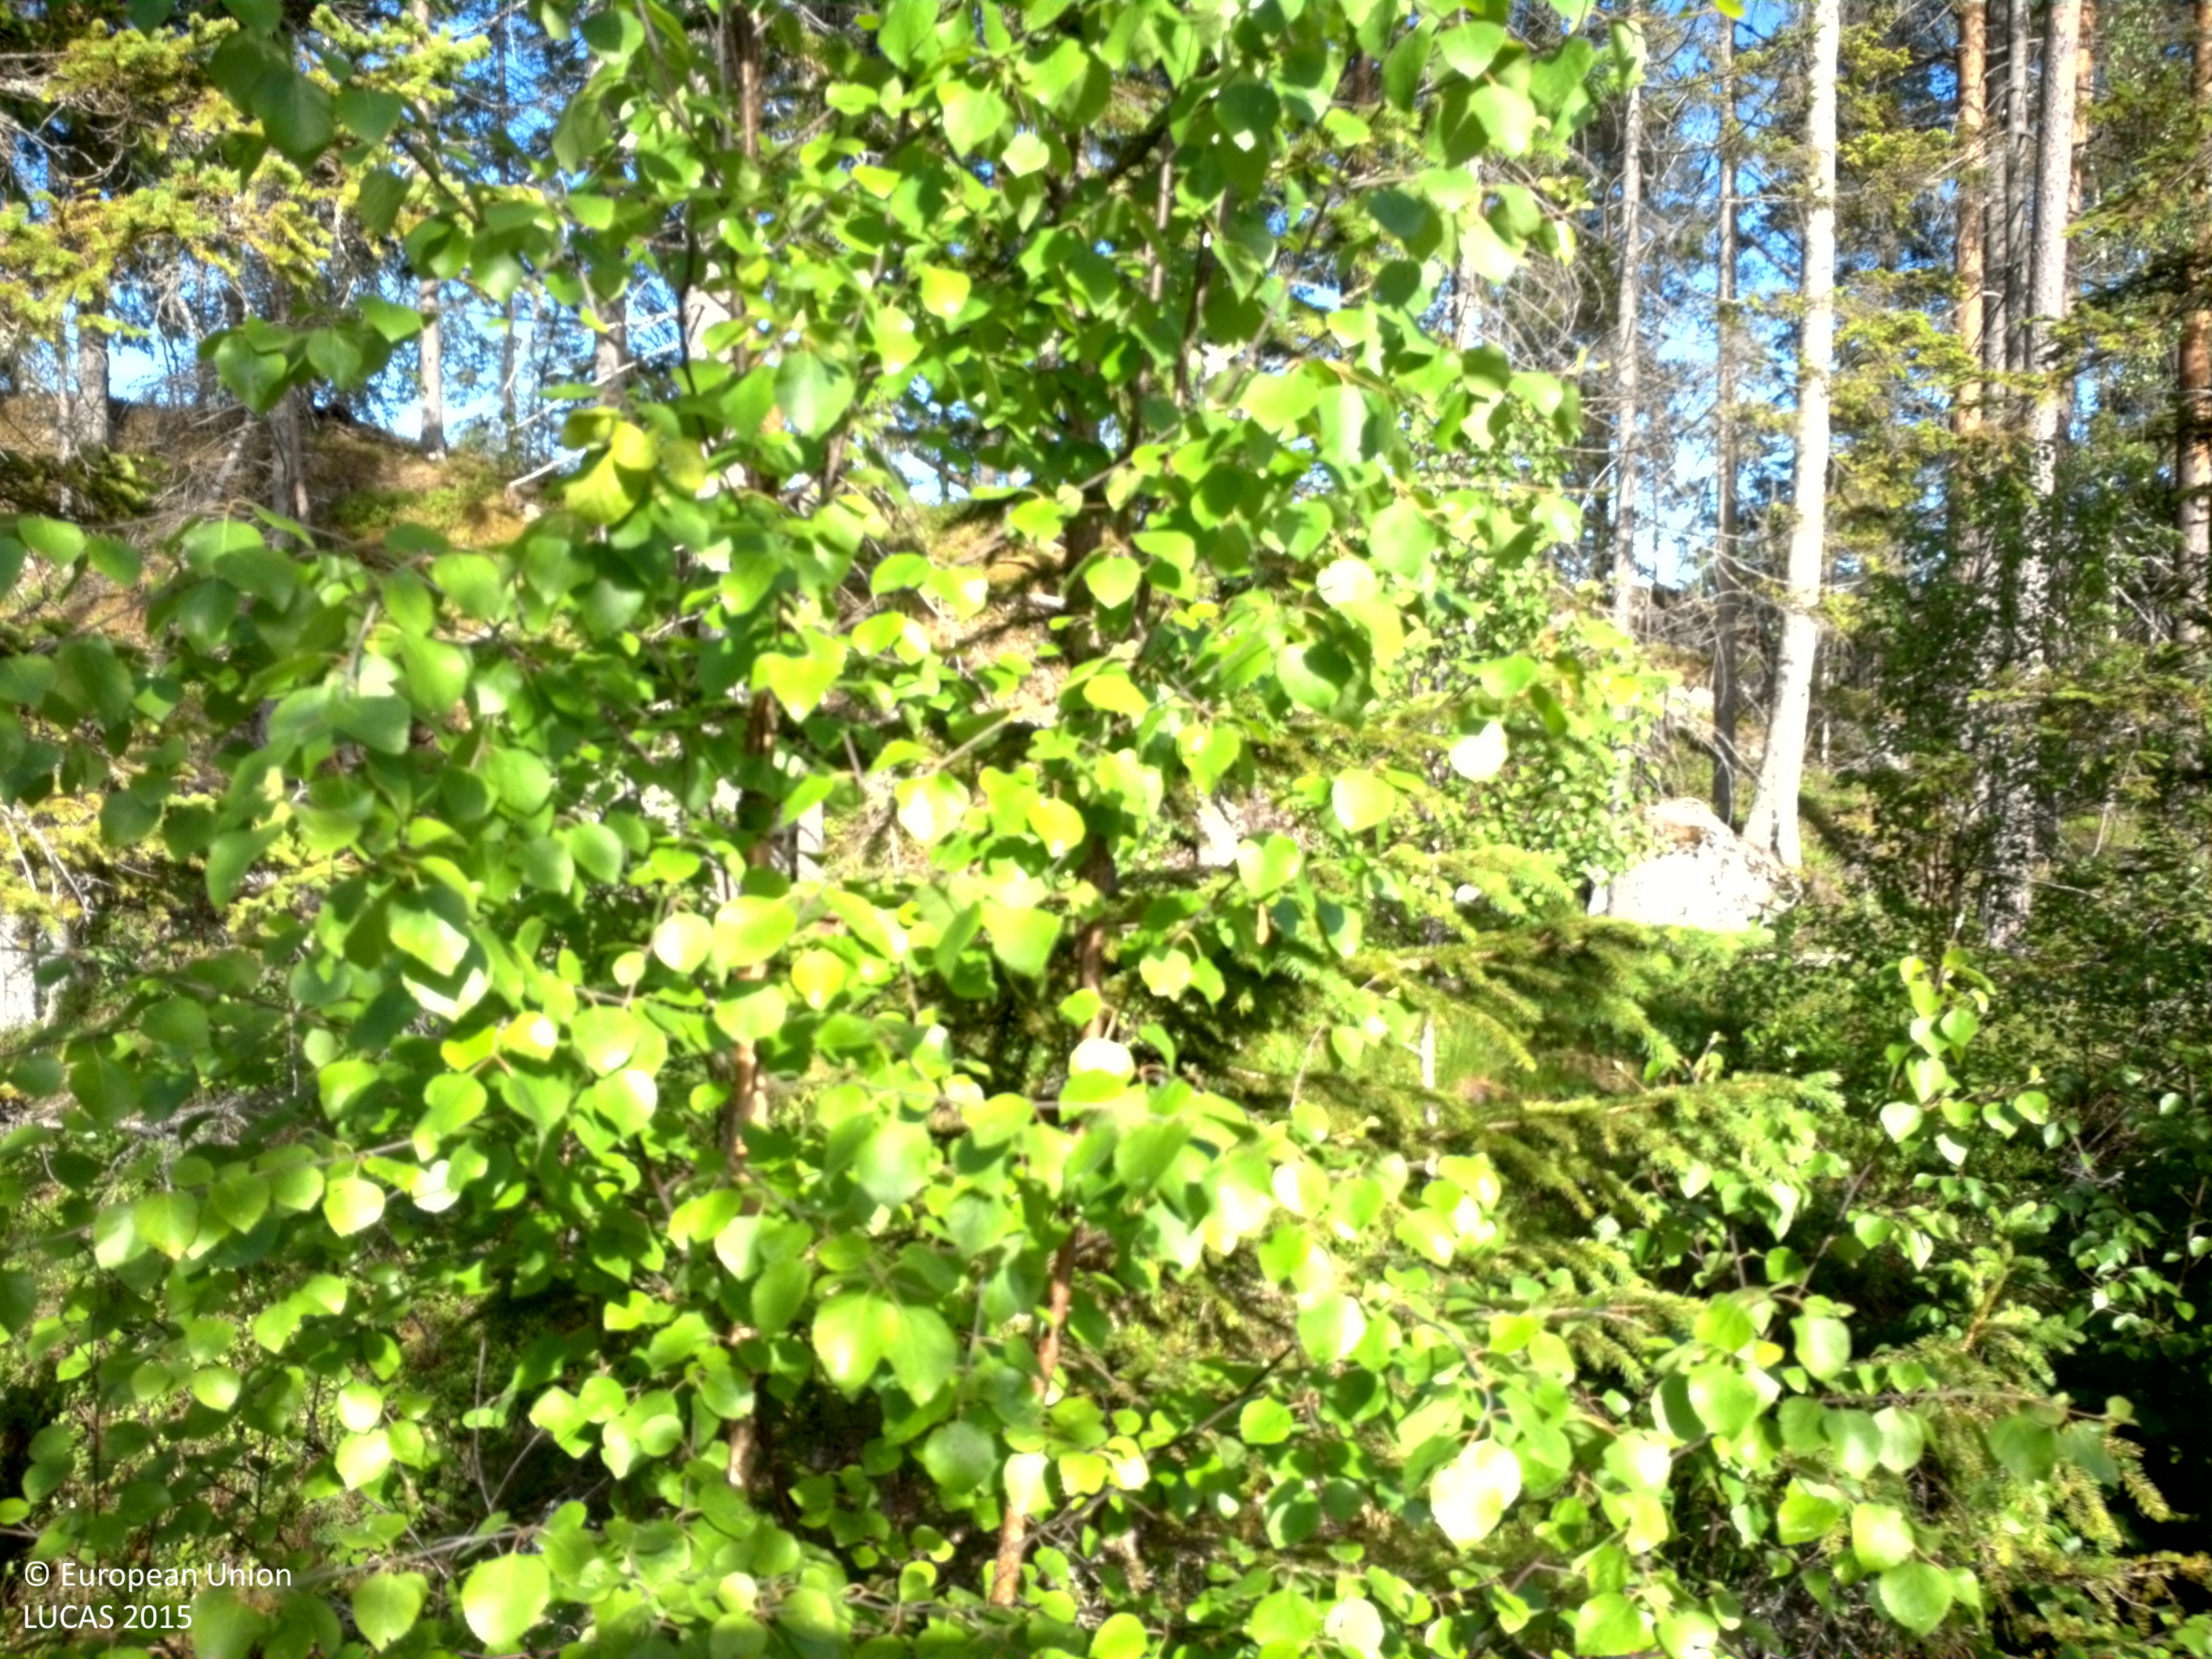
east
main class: Woodland
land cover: Spruce dominated mixed woodland
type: boreal forest
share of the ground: 25 - 50 %
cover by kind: coniferous forest trees 30 %, shrubs 25 %, herbaceous plants 25 %, broadleaved forest trees 20 %
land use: Forestry
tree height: < 5 m
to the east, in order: Spruce dominated mixed woodland; Ditches and canals; Pine dominated coniferous woodland; Pine dominated mixed woodland; Broadleaved woodland; Pine dominated mixed woodland; Spruce dominated coniferous woodland; Ditches and canals; Abandoned hedges; Fences; Grassland without tree/shrub cover
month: June
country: SE
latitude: 64.2198
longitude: 20.6766
